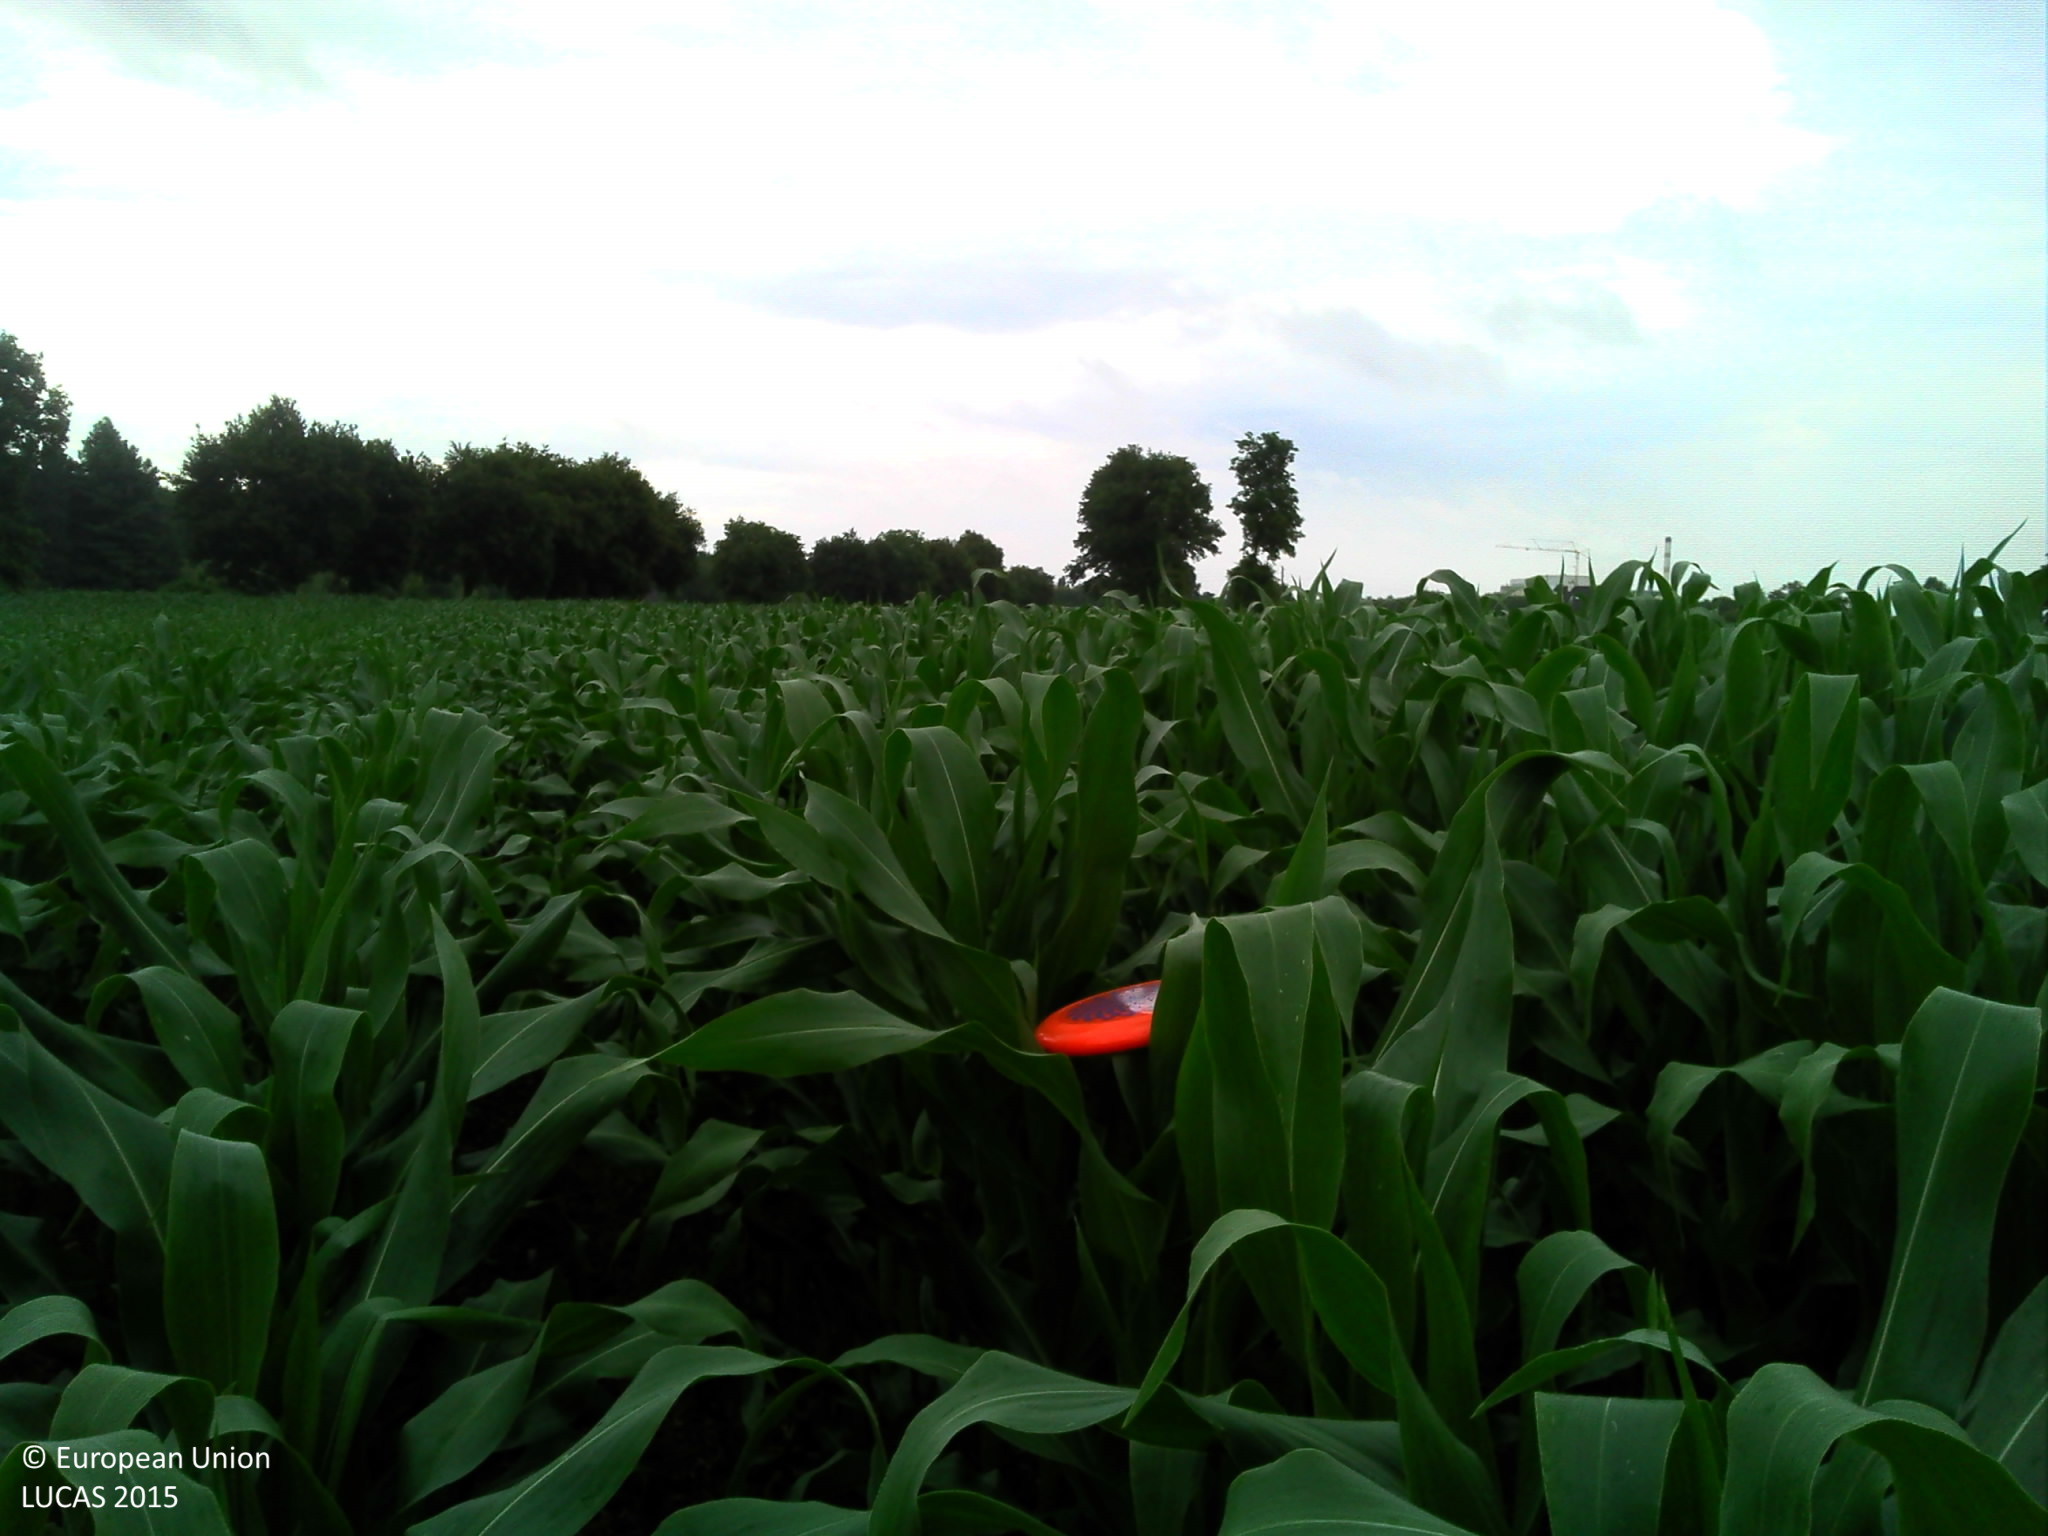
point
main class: Cropland
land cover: Maize
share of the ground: > 75 %
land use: Agriculture (excluding fallow land and kitchen gardens)
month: July
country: FR
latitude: 47.9025
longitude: -1.4009
